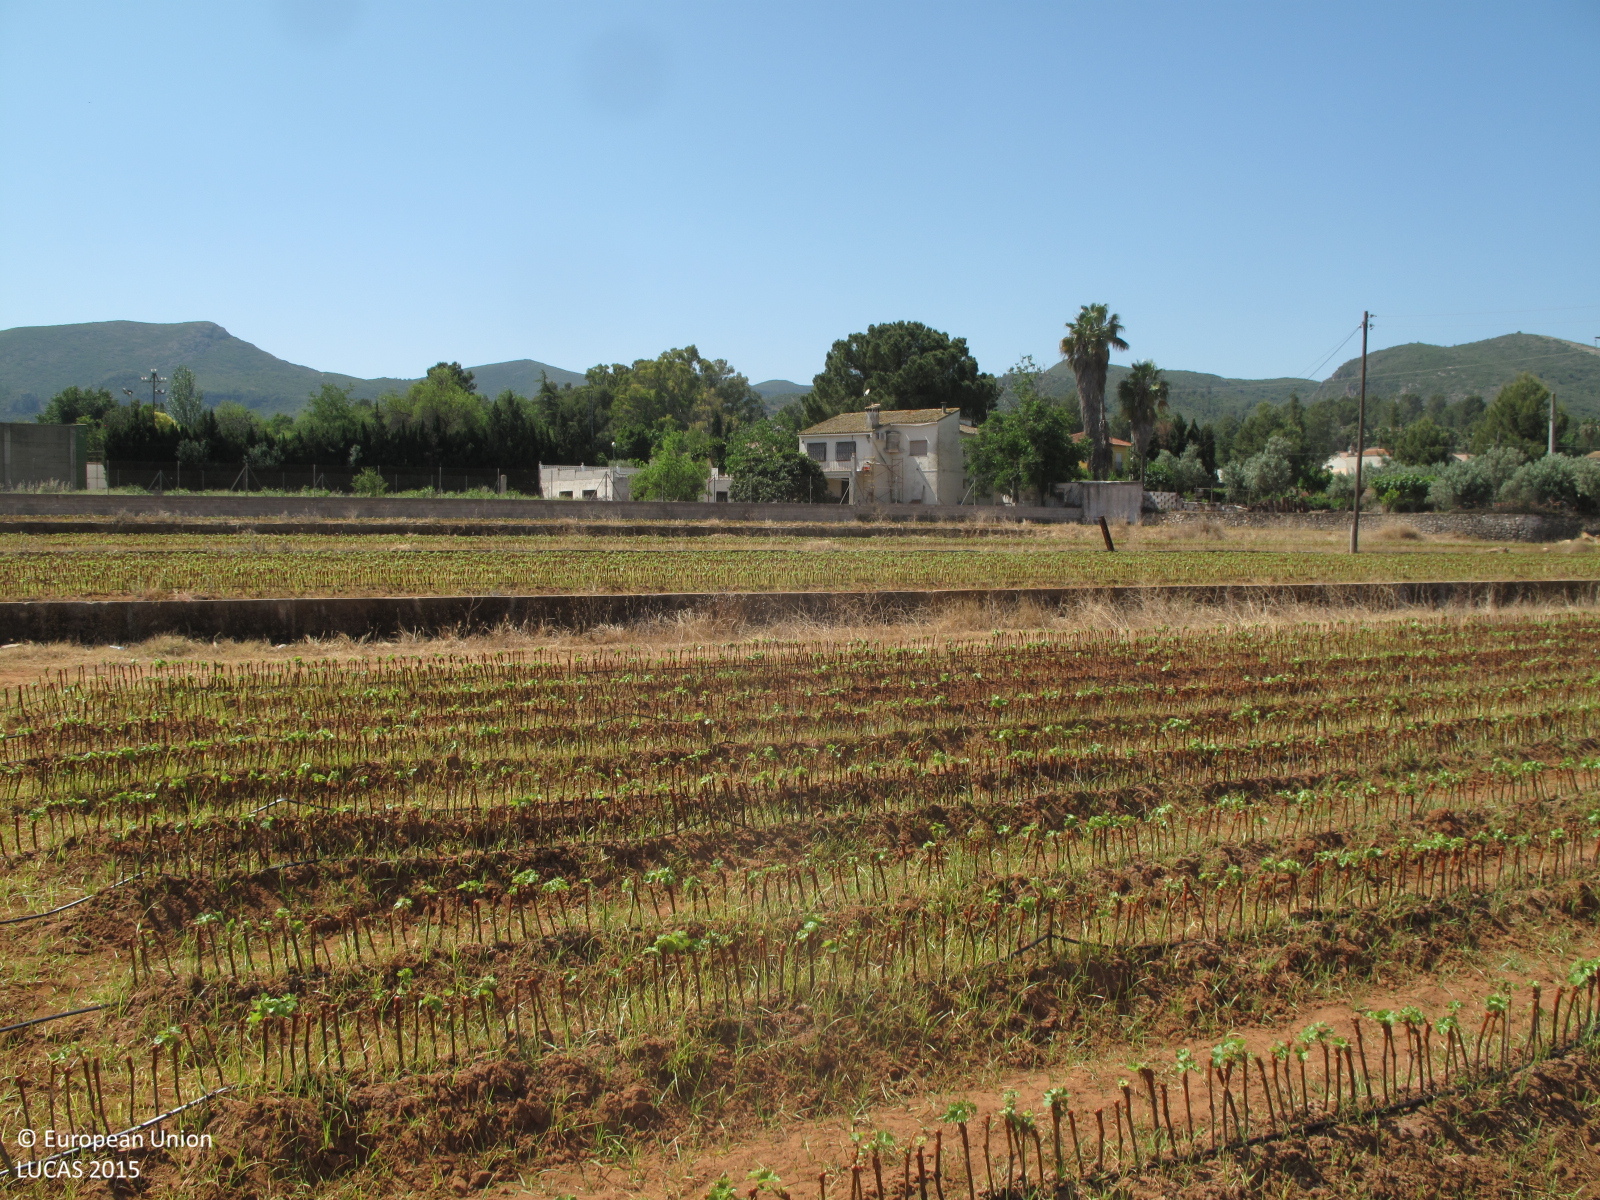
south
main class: Cropland
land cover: Vineyards
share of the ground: 10 - 25 %
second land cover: Spontaneously vegetated surfaces
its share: 10 - 25 %
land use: Agriculture (excluding fallow land and kitchen gardens)
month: May
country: ES
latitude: 38.9439
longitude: -0.5956
